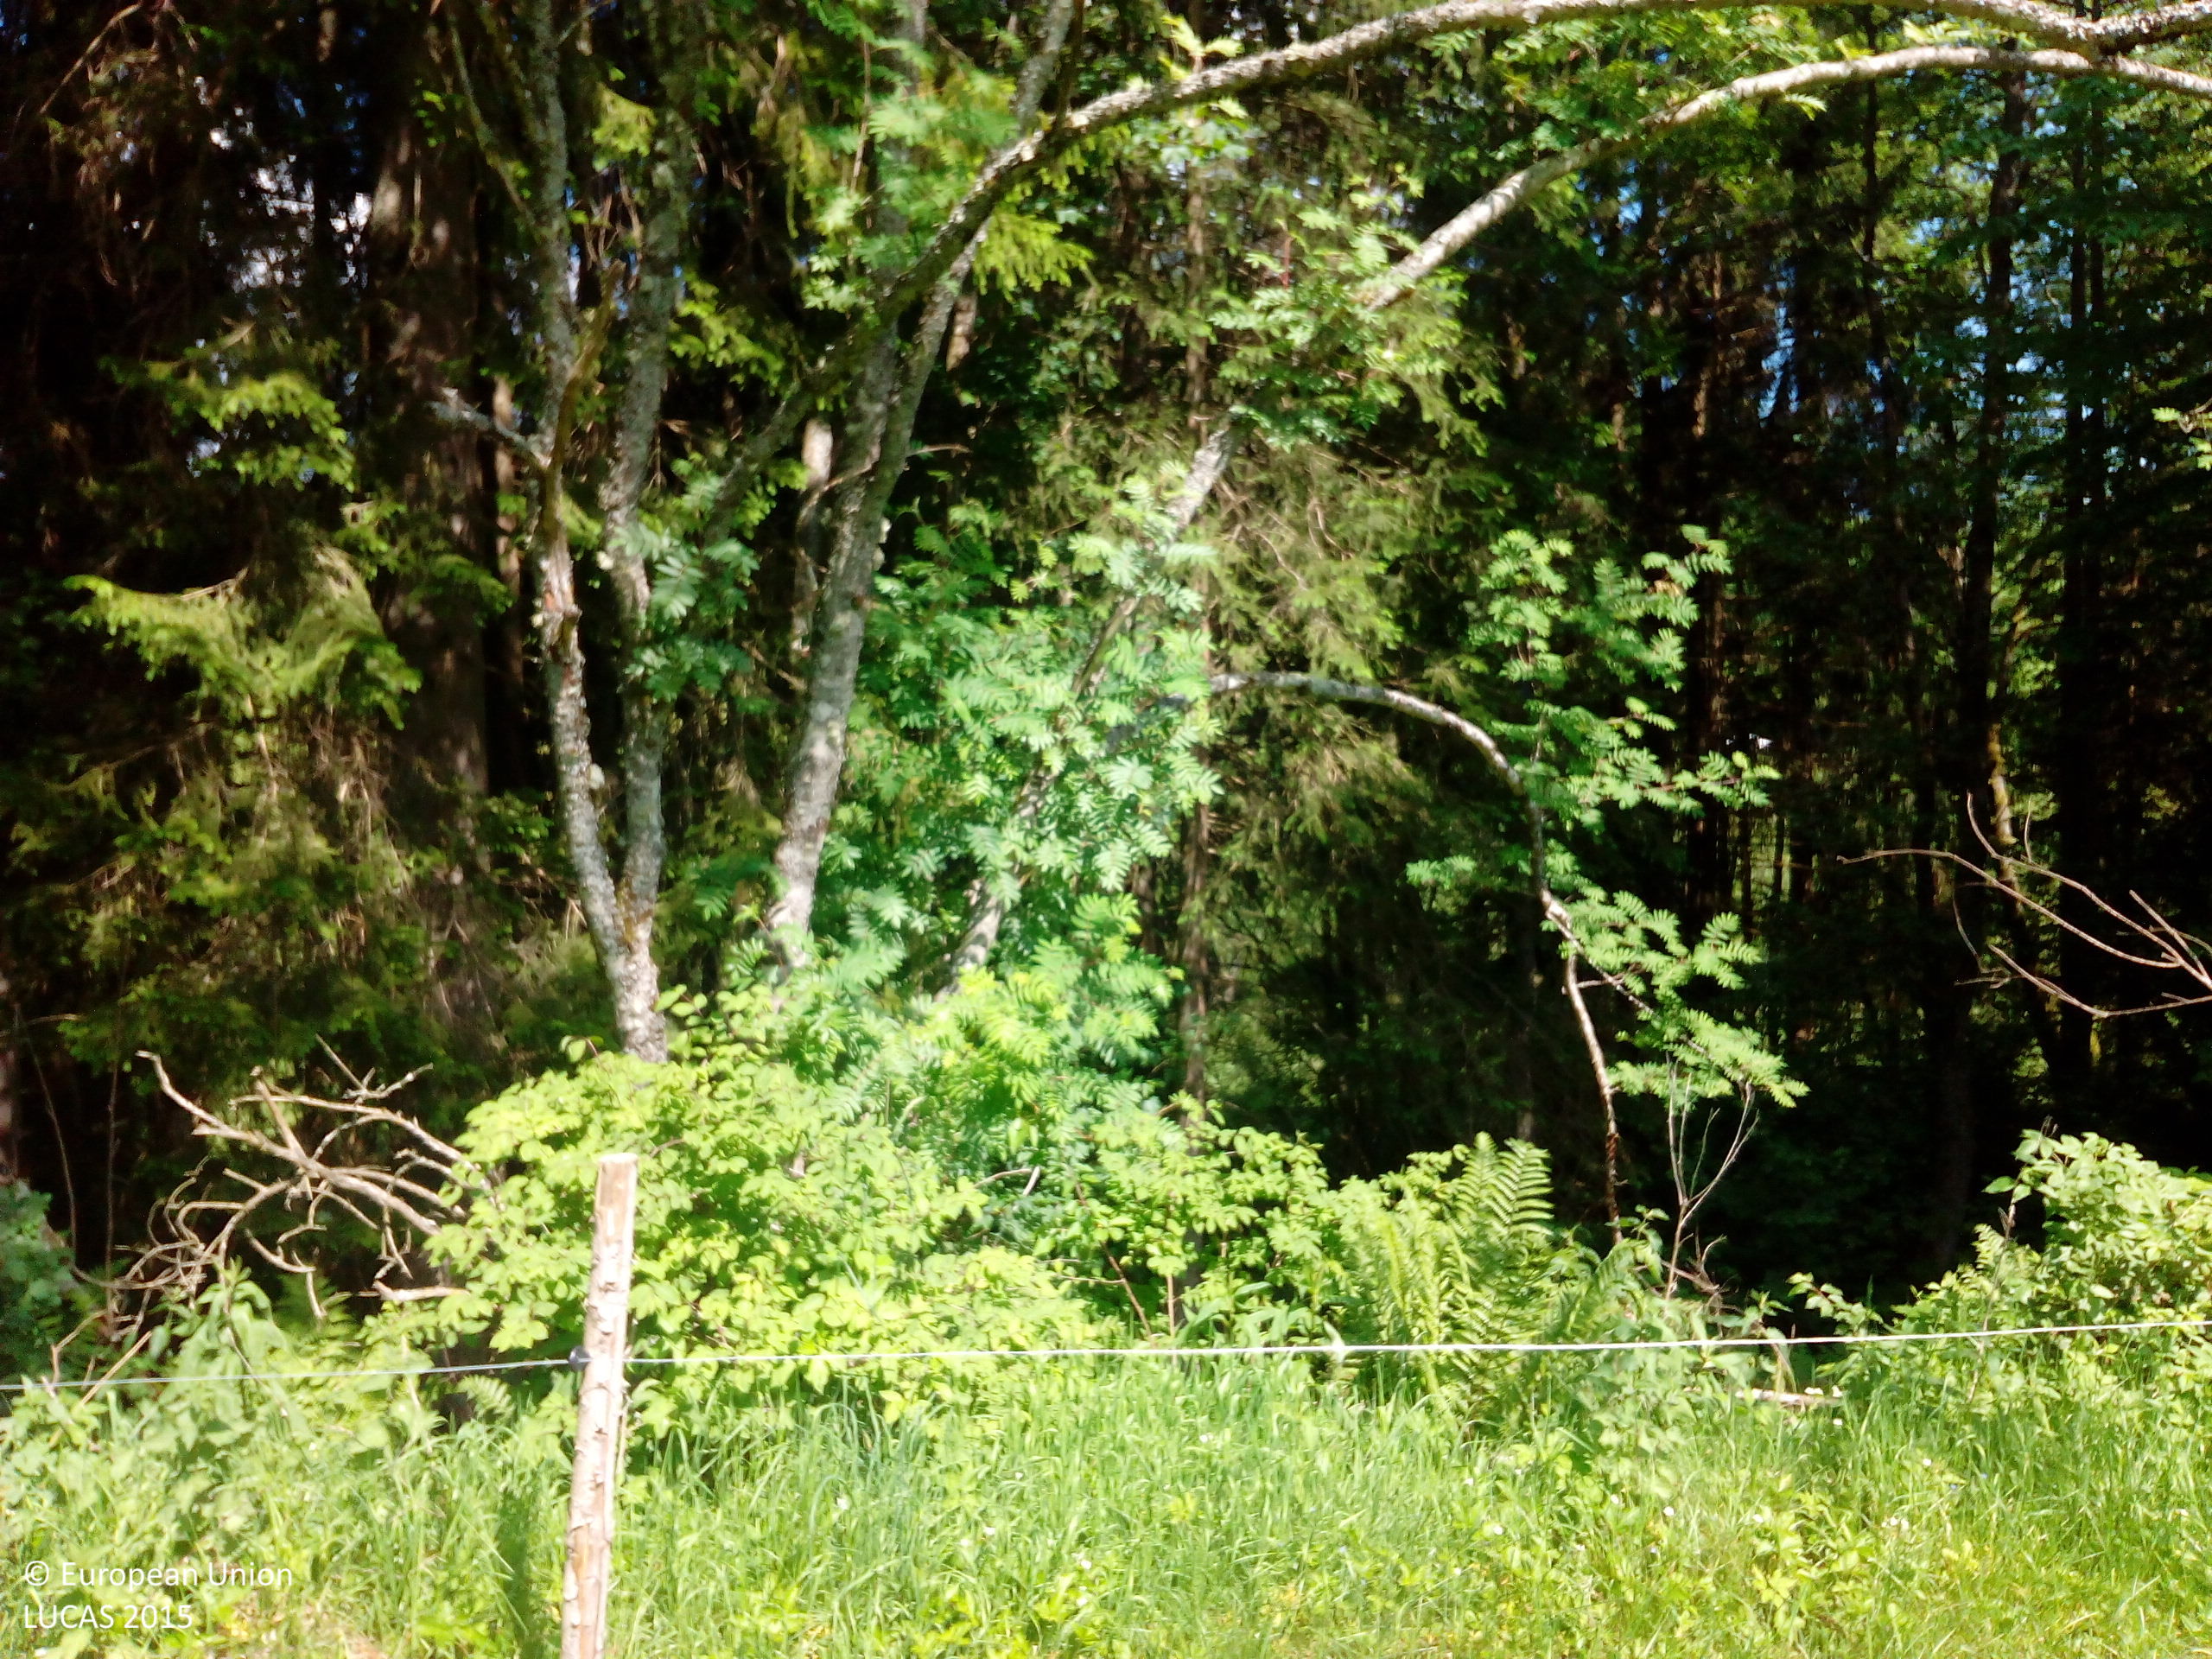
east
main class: Woodland
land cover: Broadleaved woodland
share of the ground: > 75 %
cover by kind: broadleaved forest trees 80 %, shrubs 10 %, herbaceous plants 10 %
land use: Forestry
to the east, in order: Broadleaved woodland; Spruce dominated coniferous woodland; Fences; Grassland with sparse tree/shrub cover; Lines of trees; Rivers and streams; Grassland without tree/shrub cover; Fences; Paved roads, cycling and walking lanes; Lines of trees; Fences; Grassland without tree/shrub cover; Fences; Tracks; Fences; Grassland without tree/shrub cover; Fences; Spruce dominated coniferous woodland; Tracks; Spruce dominated coniferous woodland
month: June
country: DE
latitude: 47.9194
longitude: 8.1143
